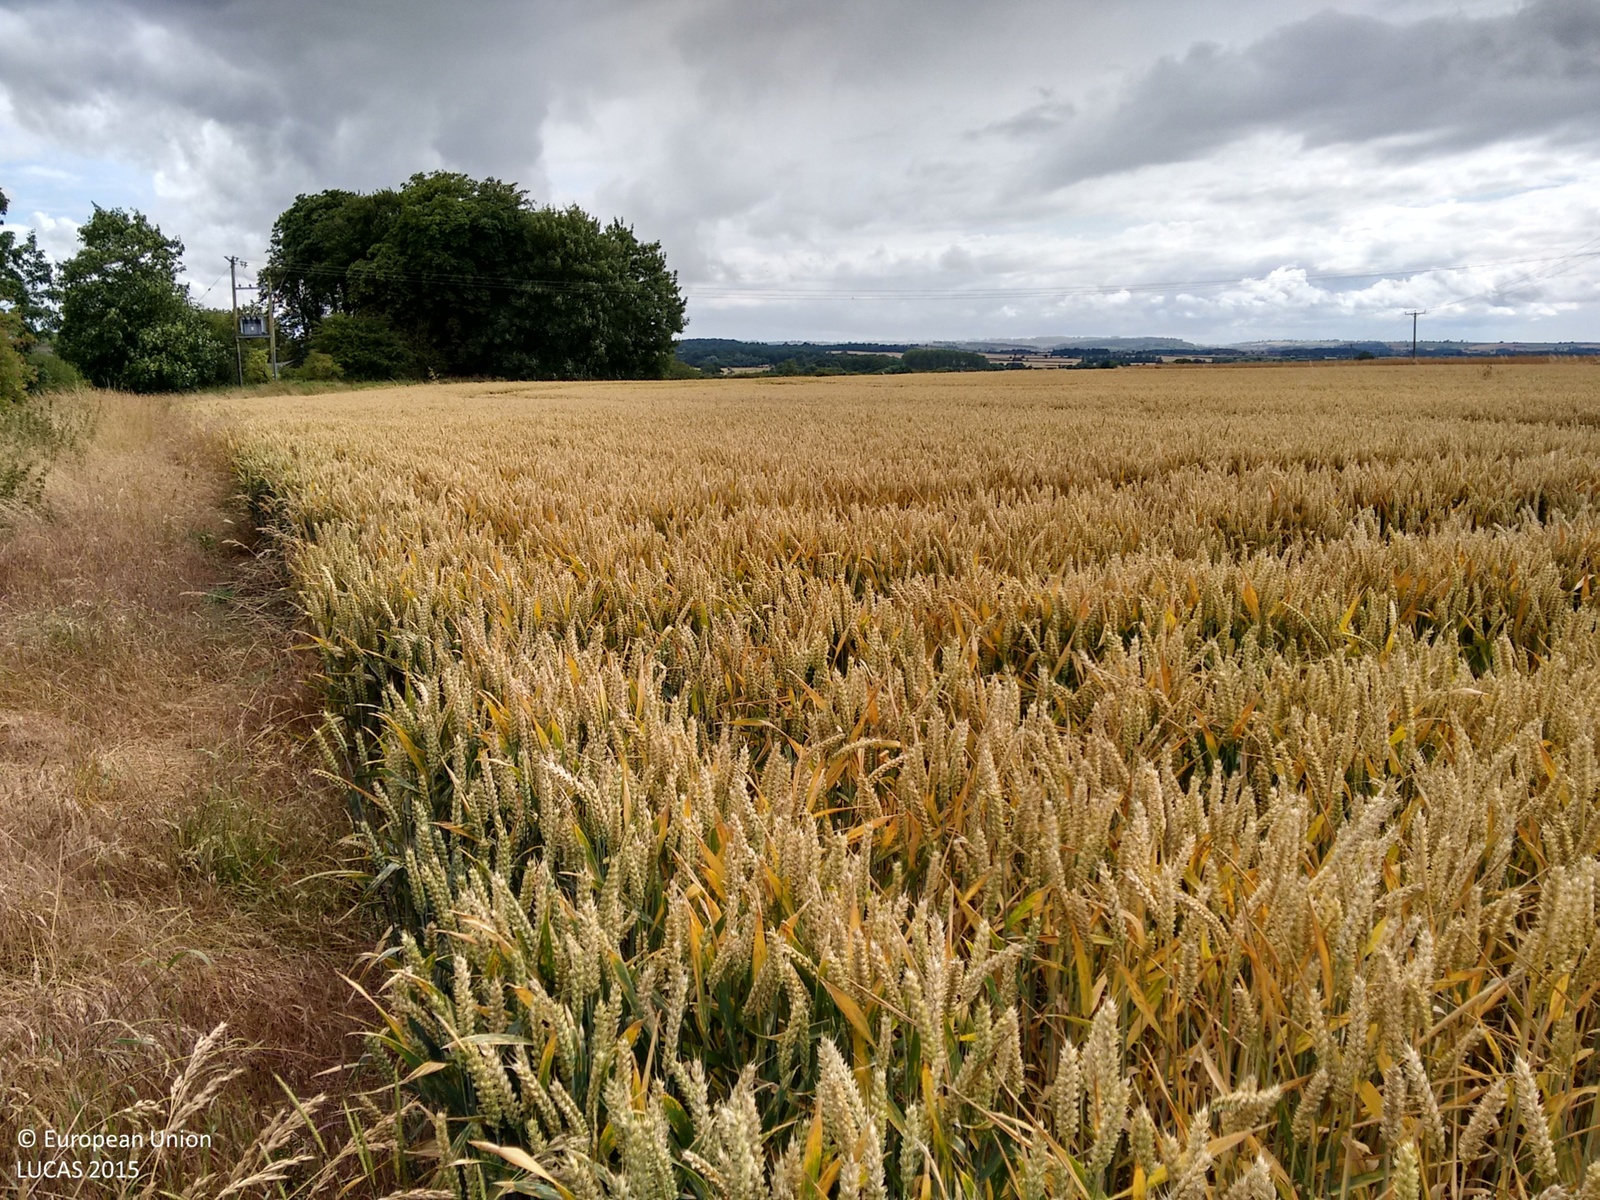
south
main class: Cropland
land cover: Common wheat
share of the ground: > 75 %
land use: Agriculture (excluding fallow land and kitchen gardens)
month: July
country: GB
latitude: 52.7733
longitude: -0.7880
